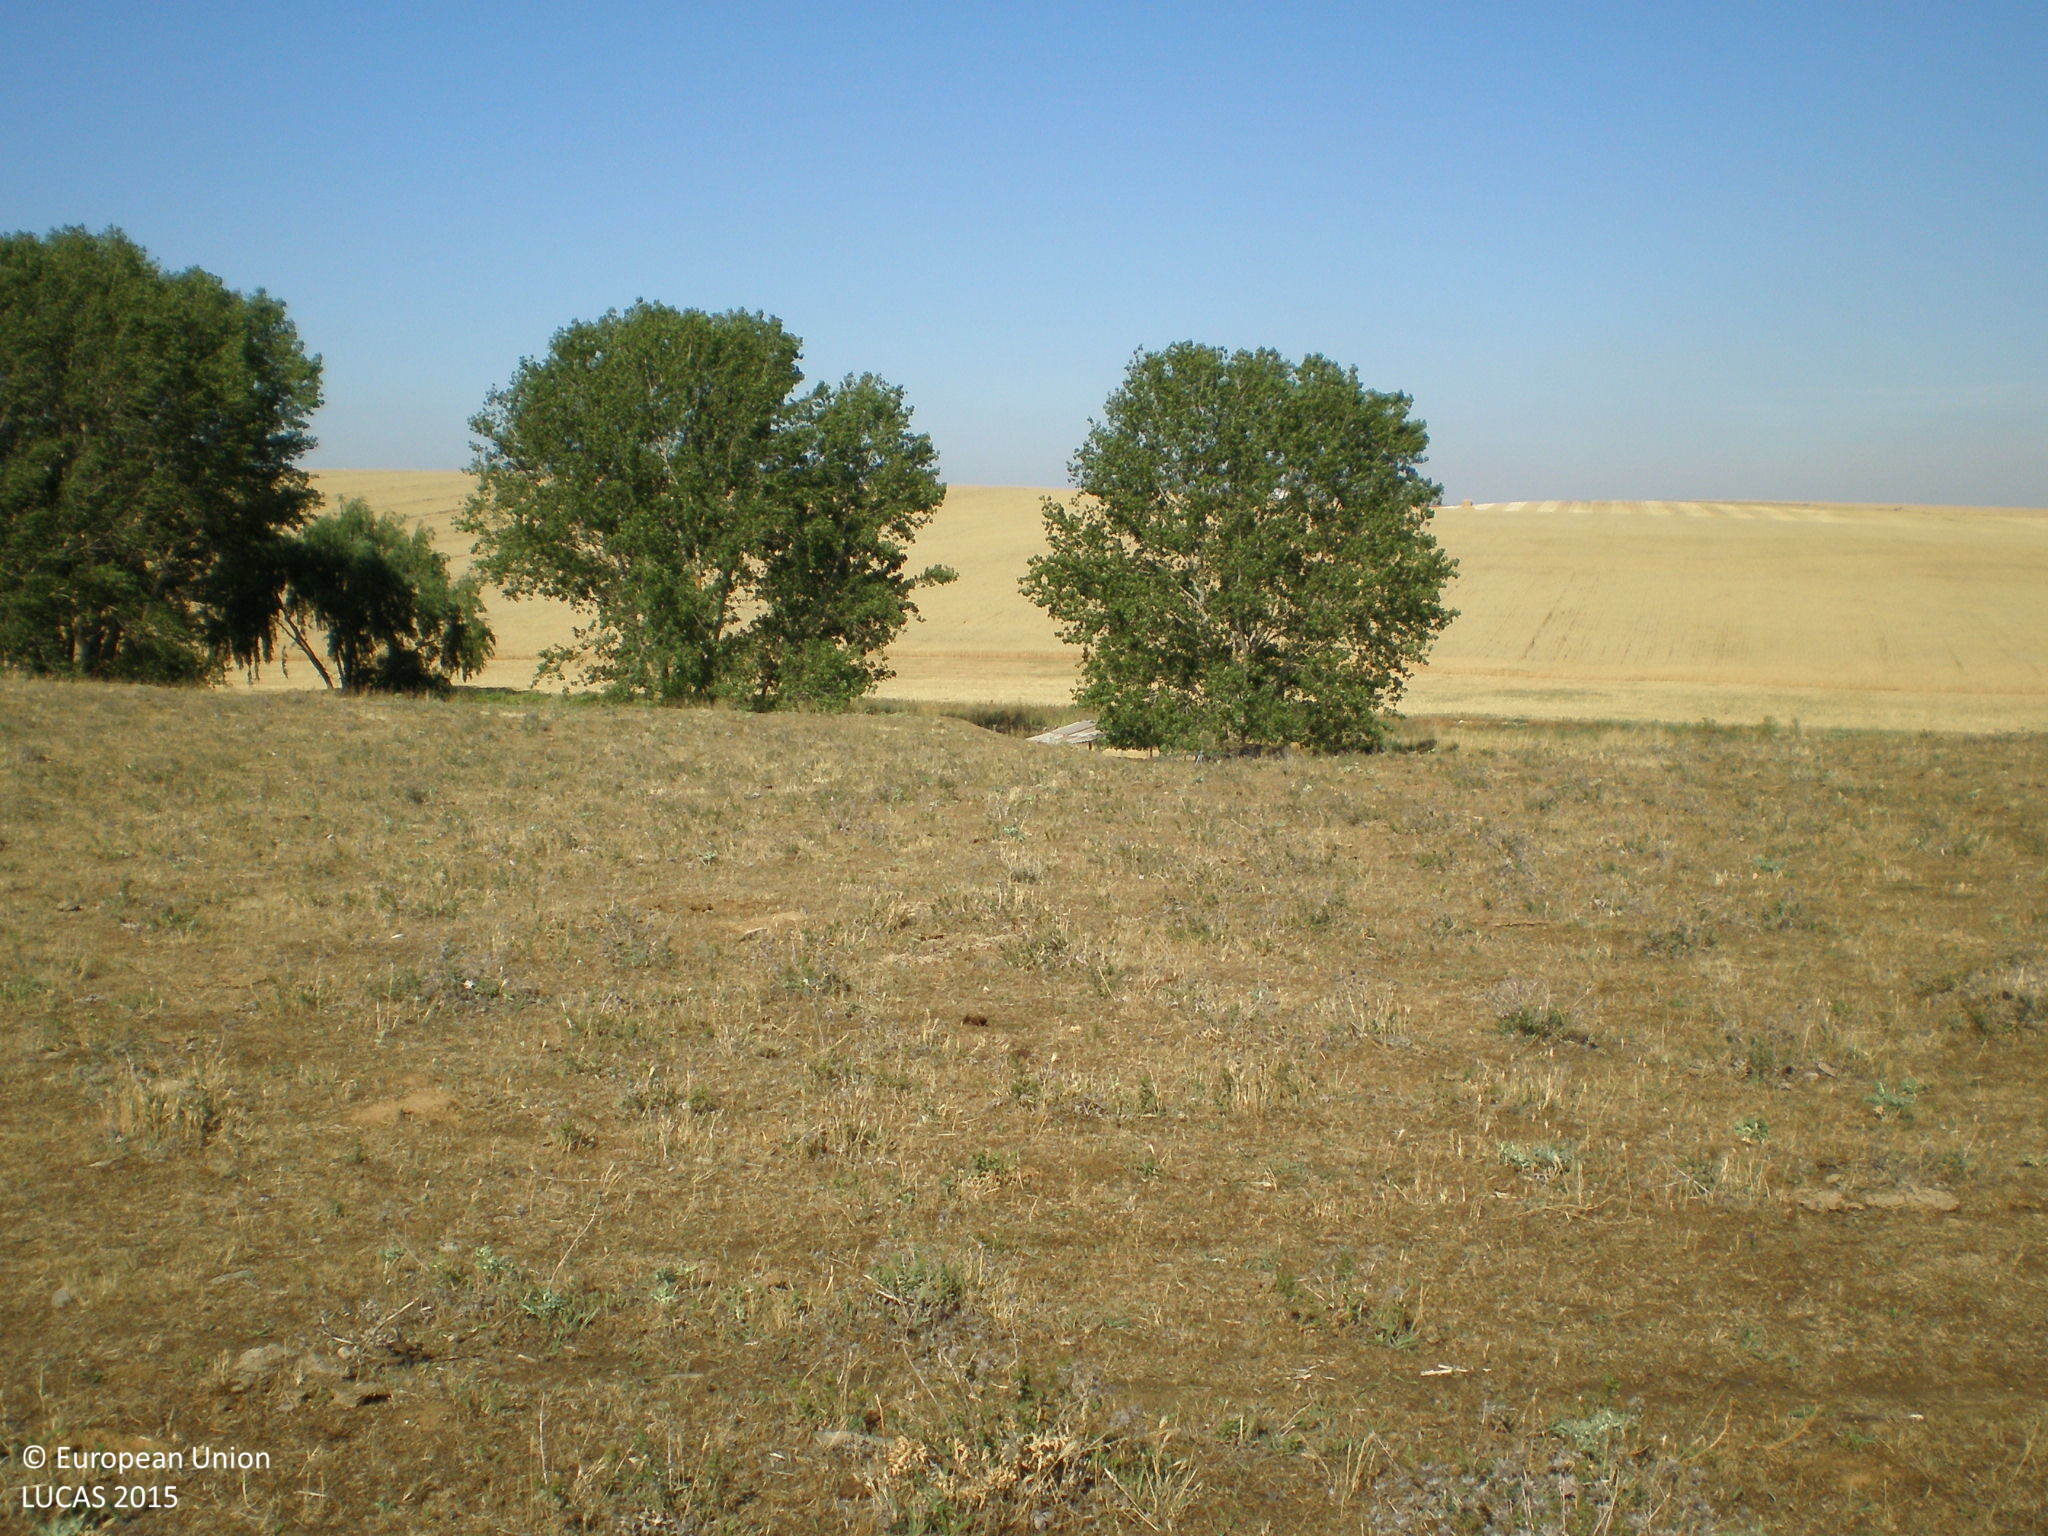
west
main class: Grassland
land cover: Grassland without tree/shrub cover
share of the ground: > 75 %
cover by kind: herbaceous plants 100 %
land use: Agriculture (excluding fallow land and kitchen gardens)
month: June
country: ES
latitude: 40.8906
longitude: -5.6841
